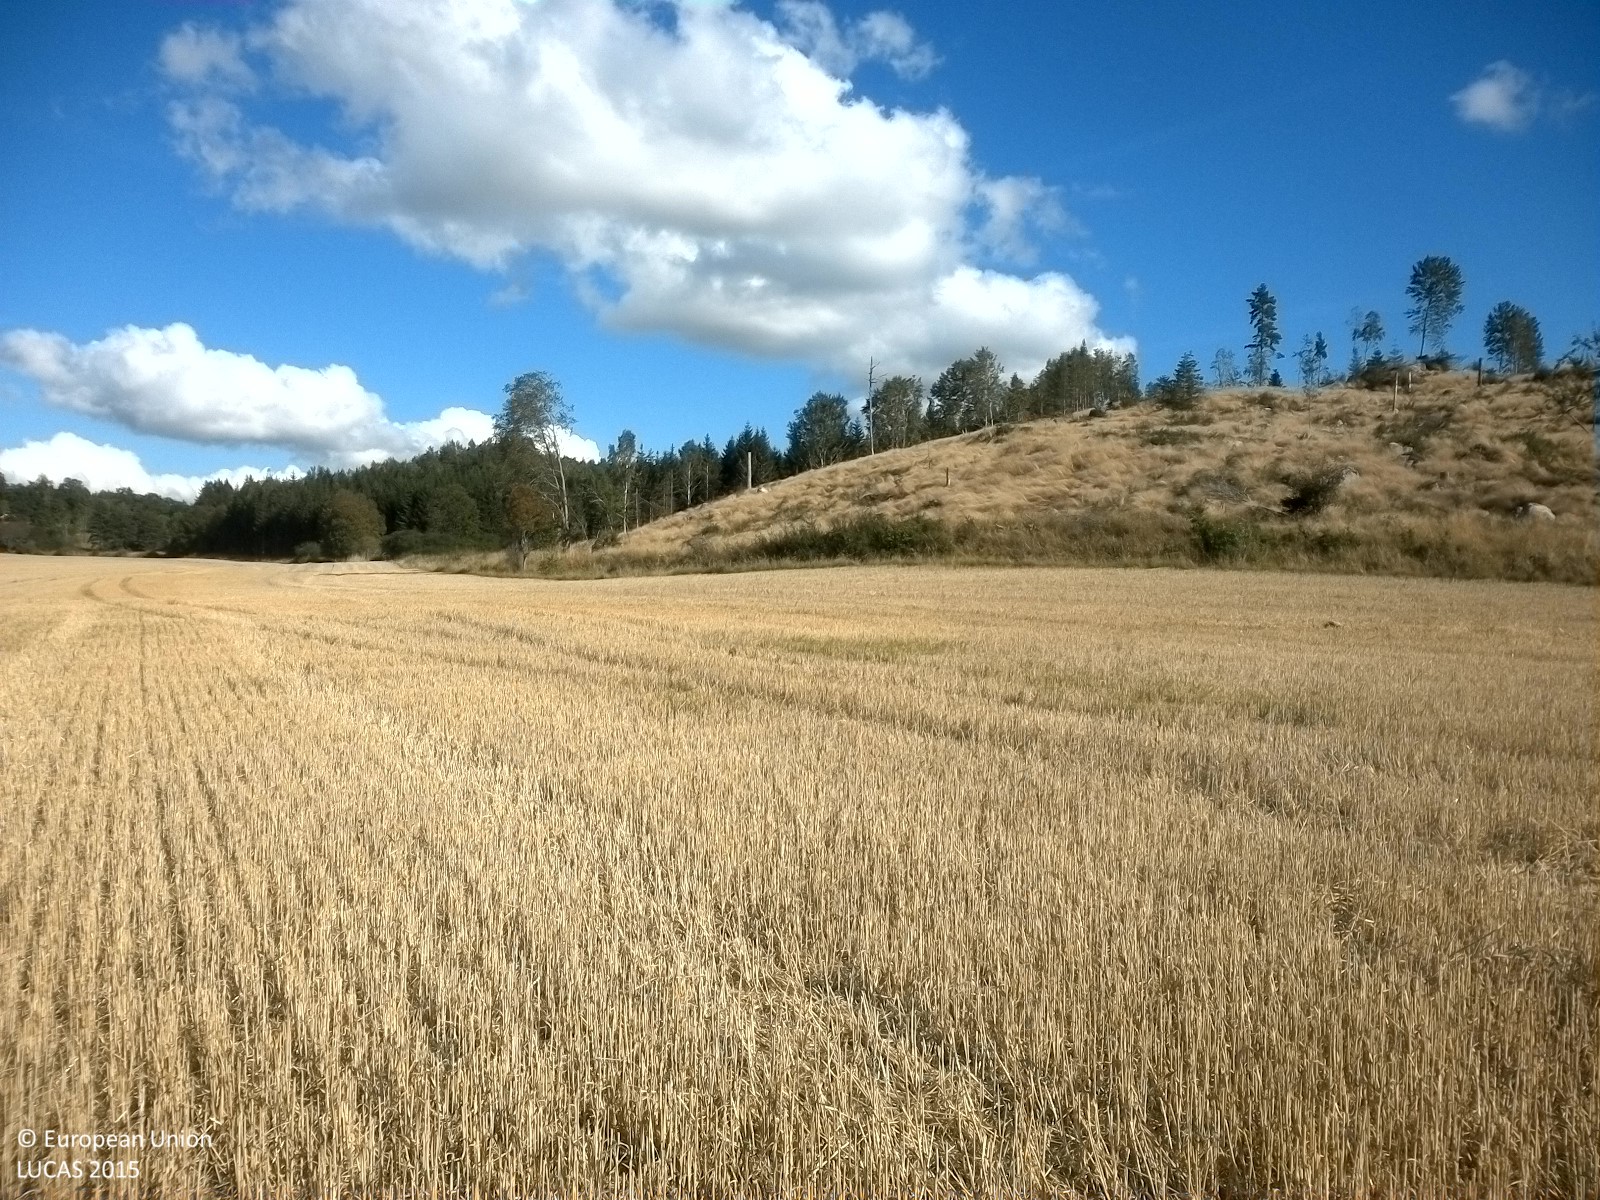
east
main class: Cropland
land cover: Common wheat
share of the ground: > 75 %
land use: Agriculture (excluding fallow land and kitchen gardens)
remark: Harvested field
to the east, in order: Common wheat; Ditches and canals; Abandoned hedges; Grassland with sparse tree/shrub cover; Shrubland without tree cover; Other bare soil; Spruce dominated coniferous woodland
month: September
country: SE
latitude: 58.4826
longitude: 16.3931
